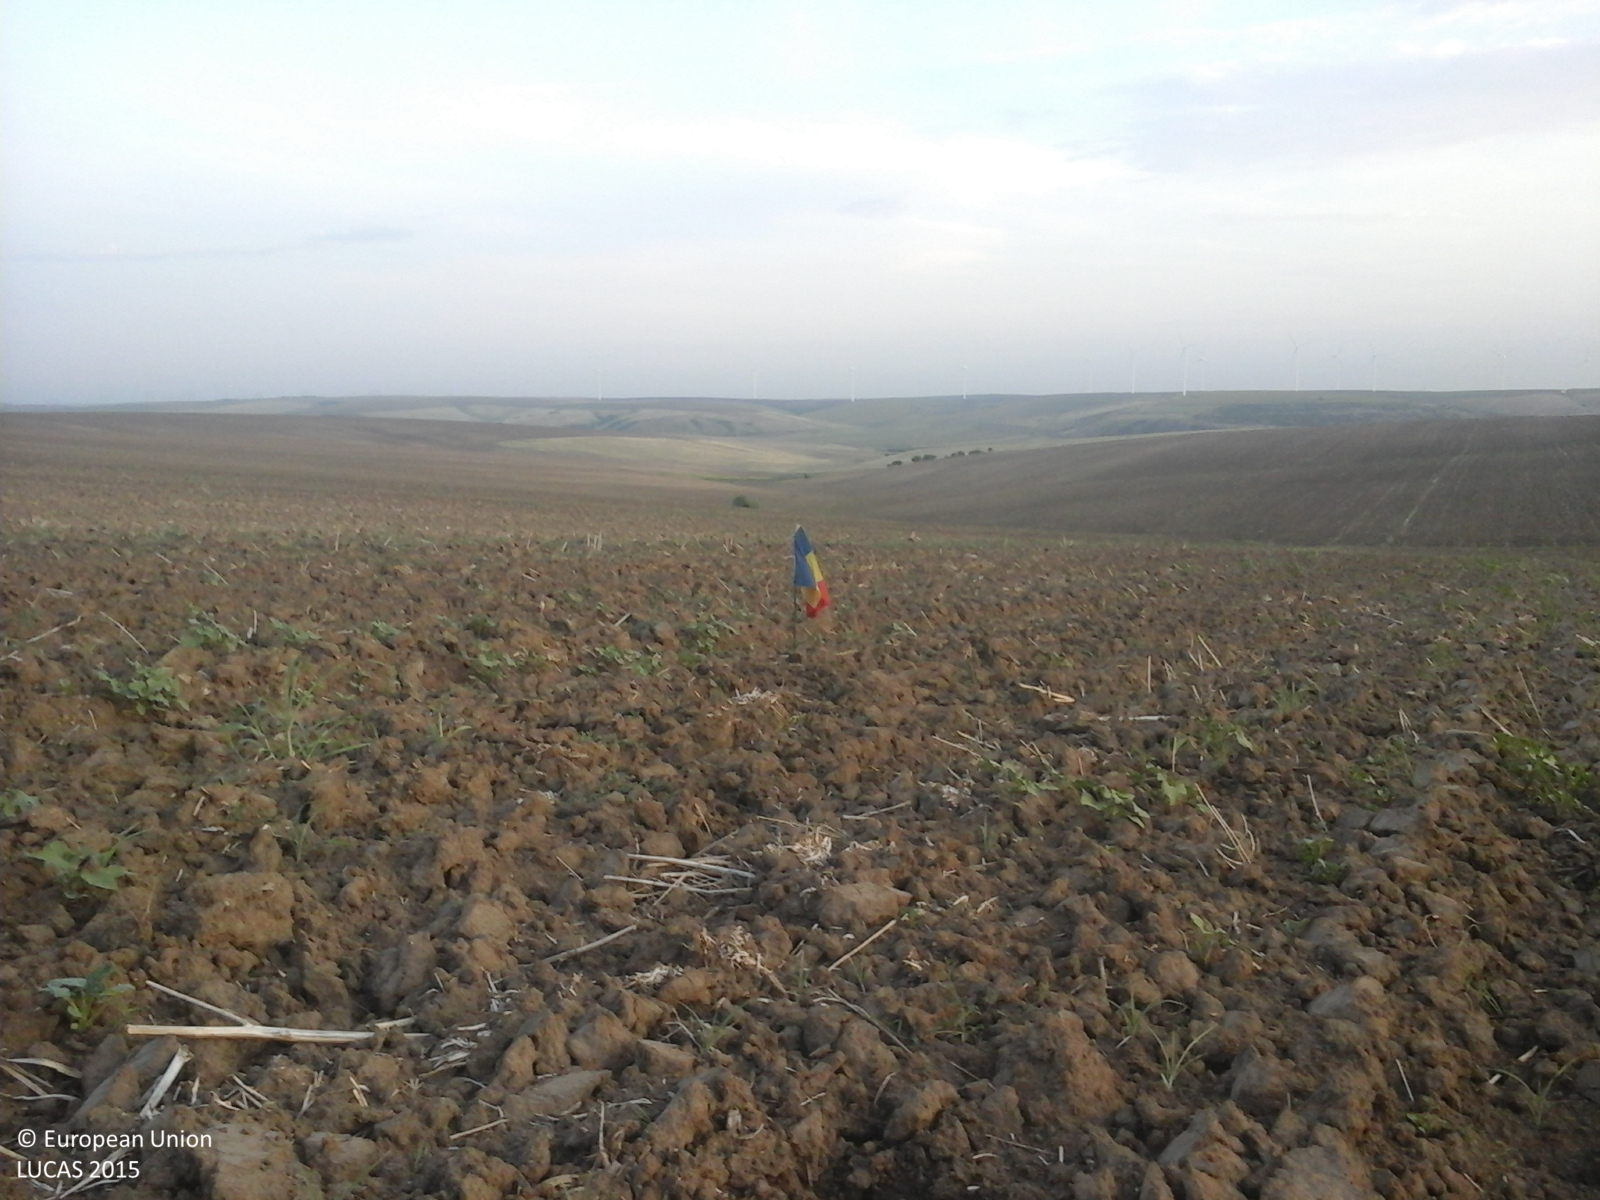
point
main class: Cropland
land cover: Rape and turnip rape
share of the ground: < 10 %
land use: Agriculture (excluding fallow land and kitchen gardens)
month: August
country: RO
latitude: 44.2411
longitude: 28.0757
